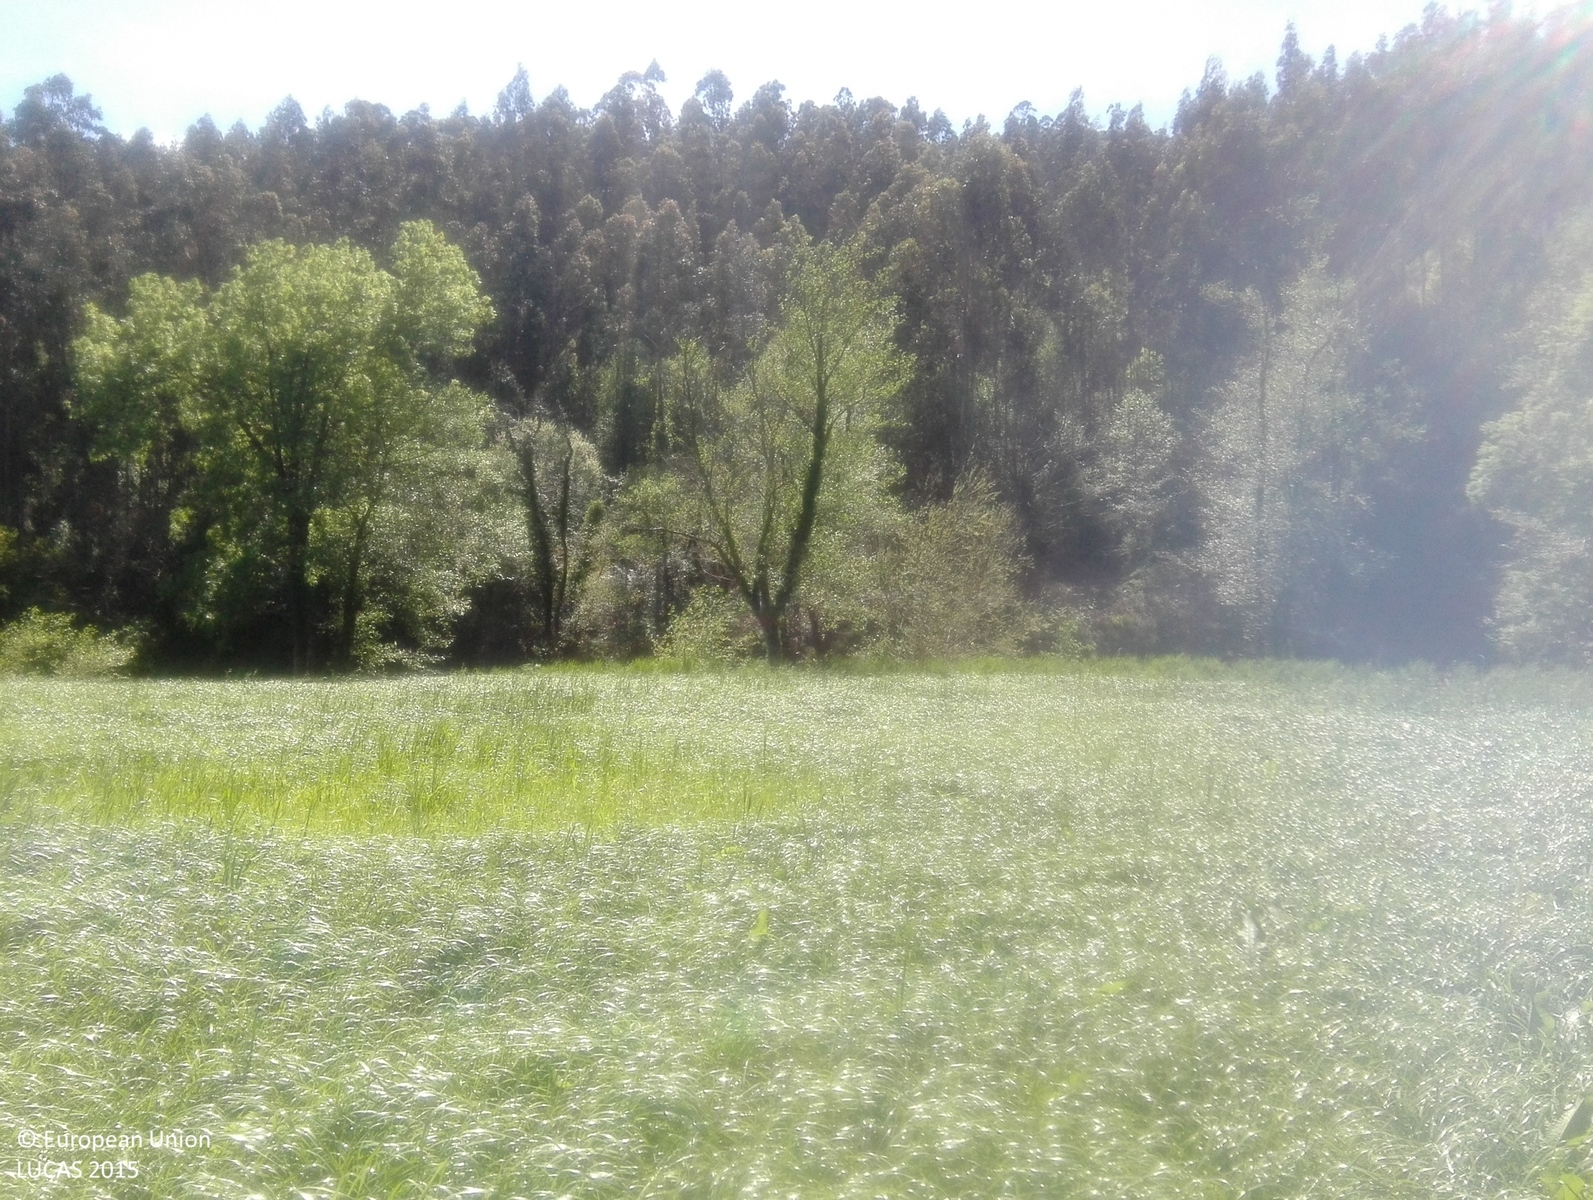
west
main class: Cropland
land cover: Temporary grasslands
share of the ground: > 75 %
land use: Agriculture (excluding fallow land and kitchen gardens)
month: April
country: ES
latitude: 43.4327
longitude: -7.1058
